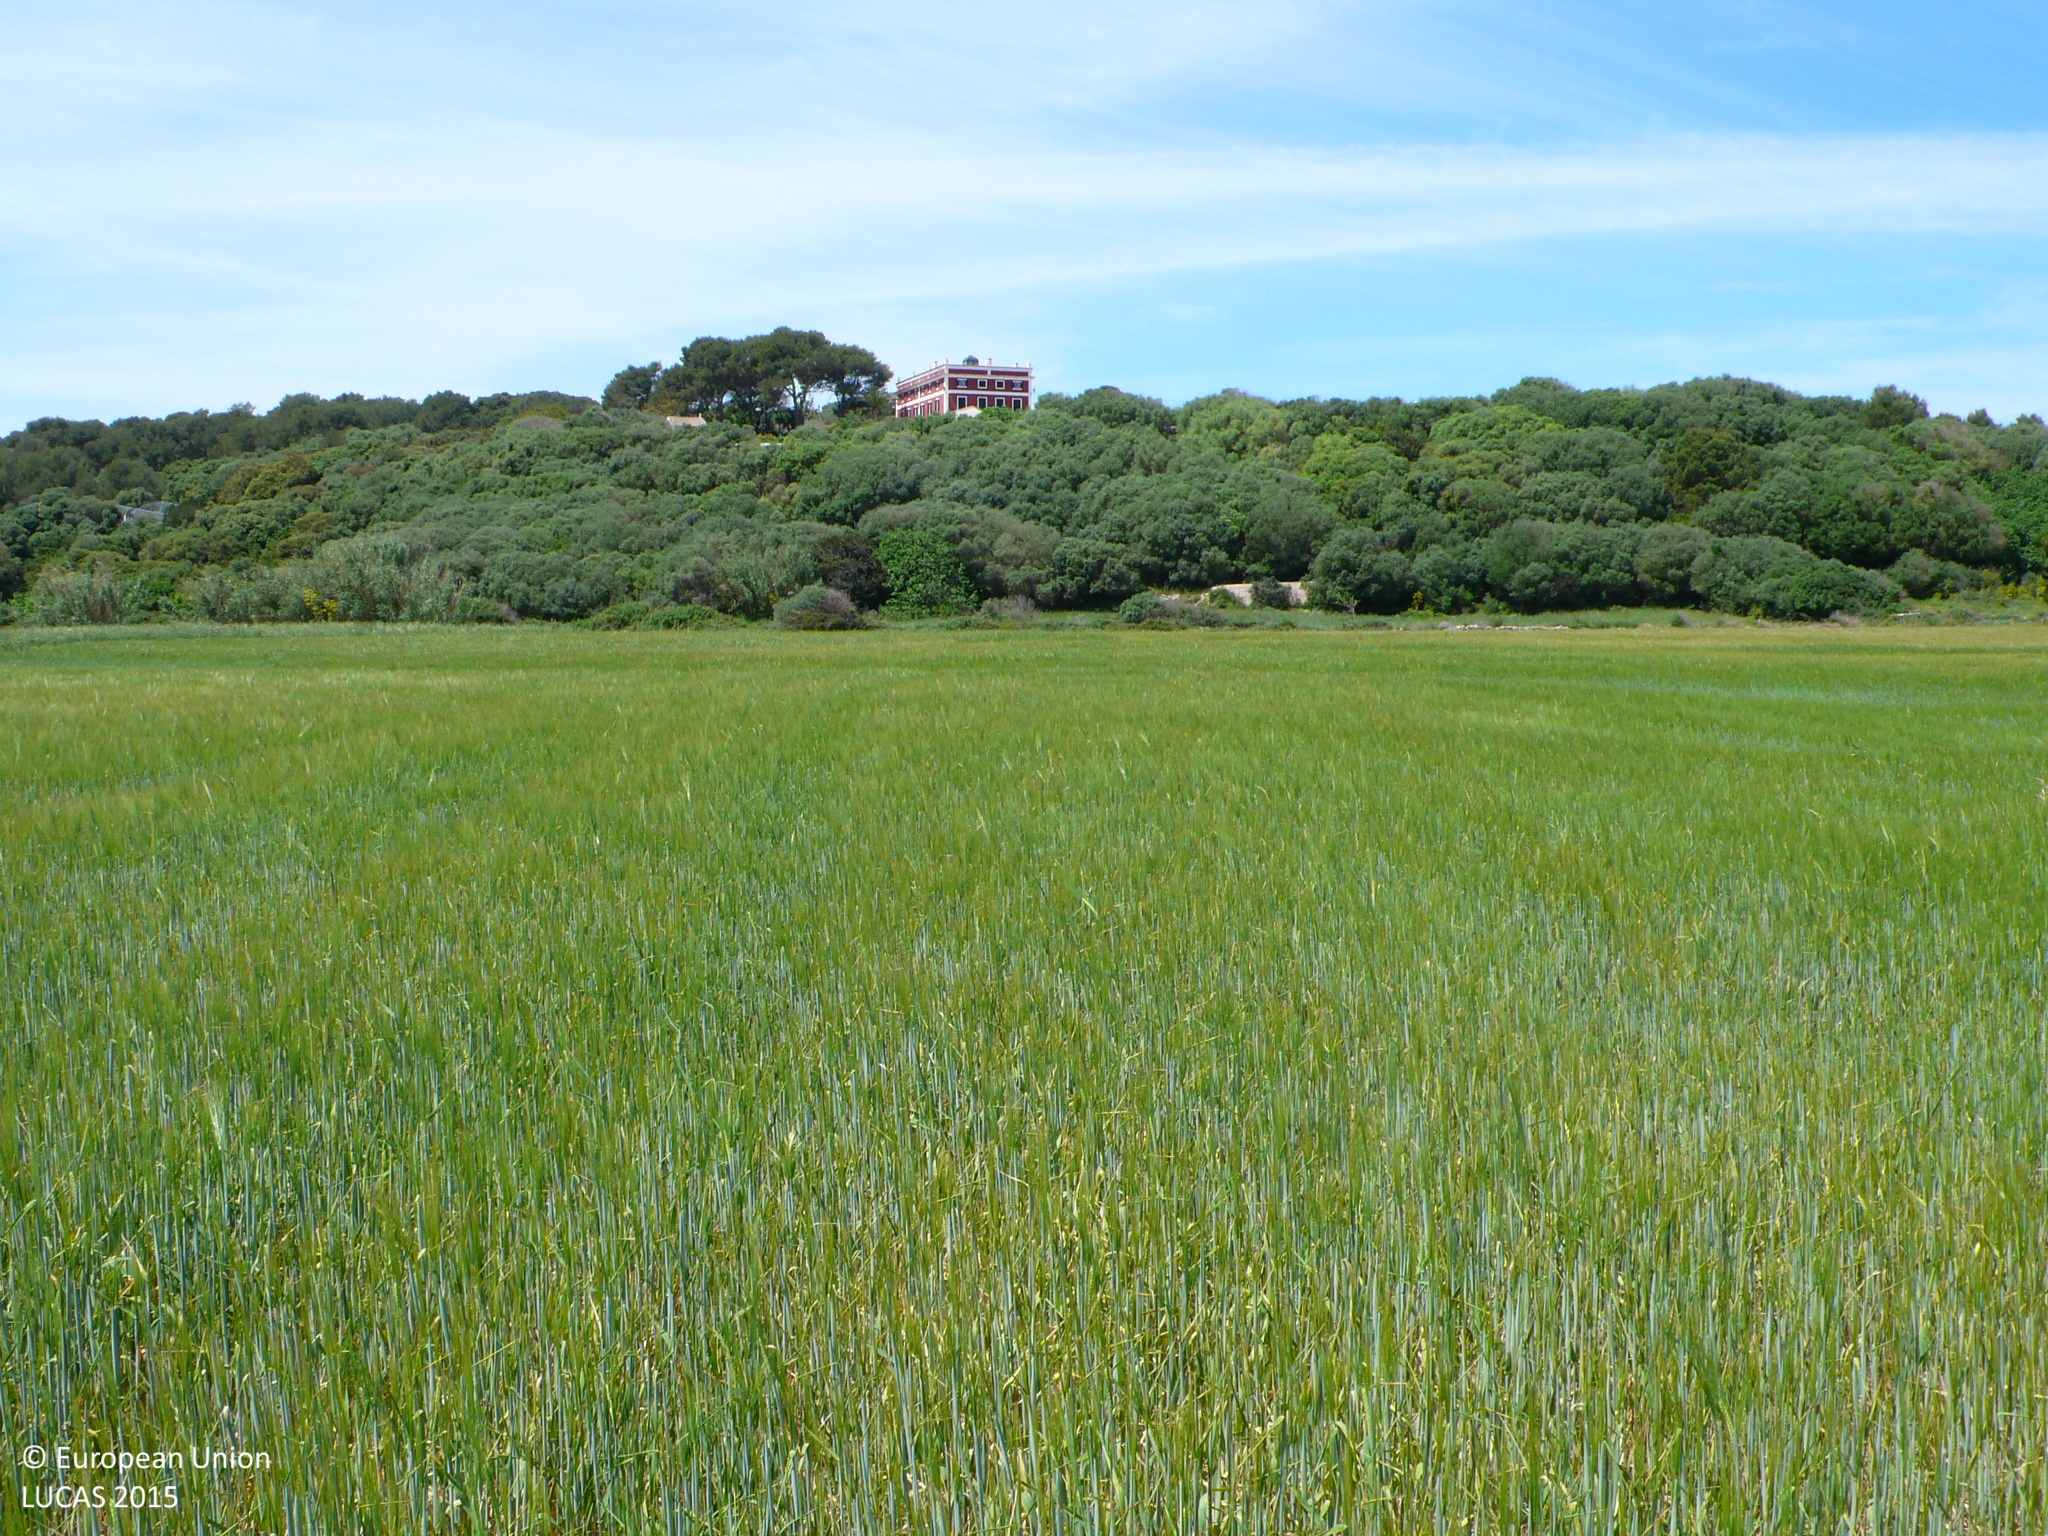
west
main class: Cropland
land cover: Barley
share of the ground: > 75 %
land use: Agriculture (excluding fallow land and kitchen gardens)
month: May
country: ES
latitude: 39.9663
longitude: 4.1604
